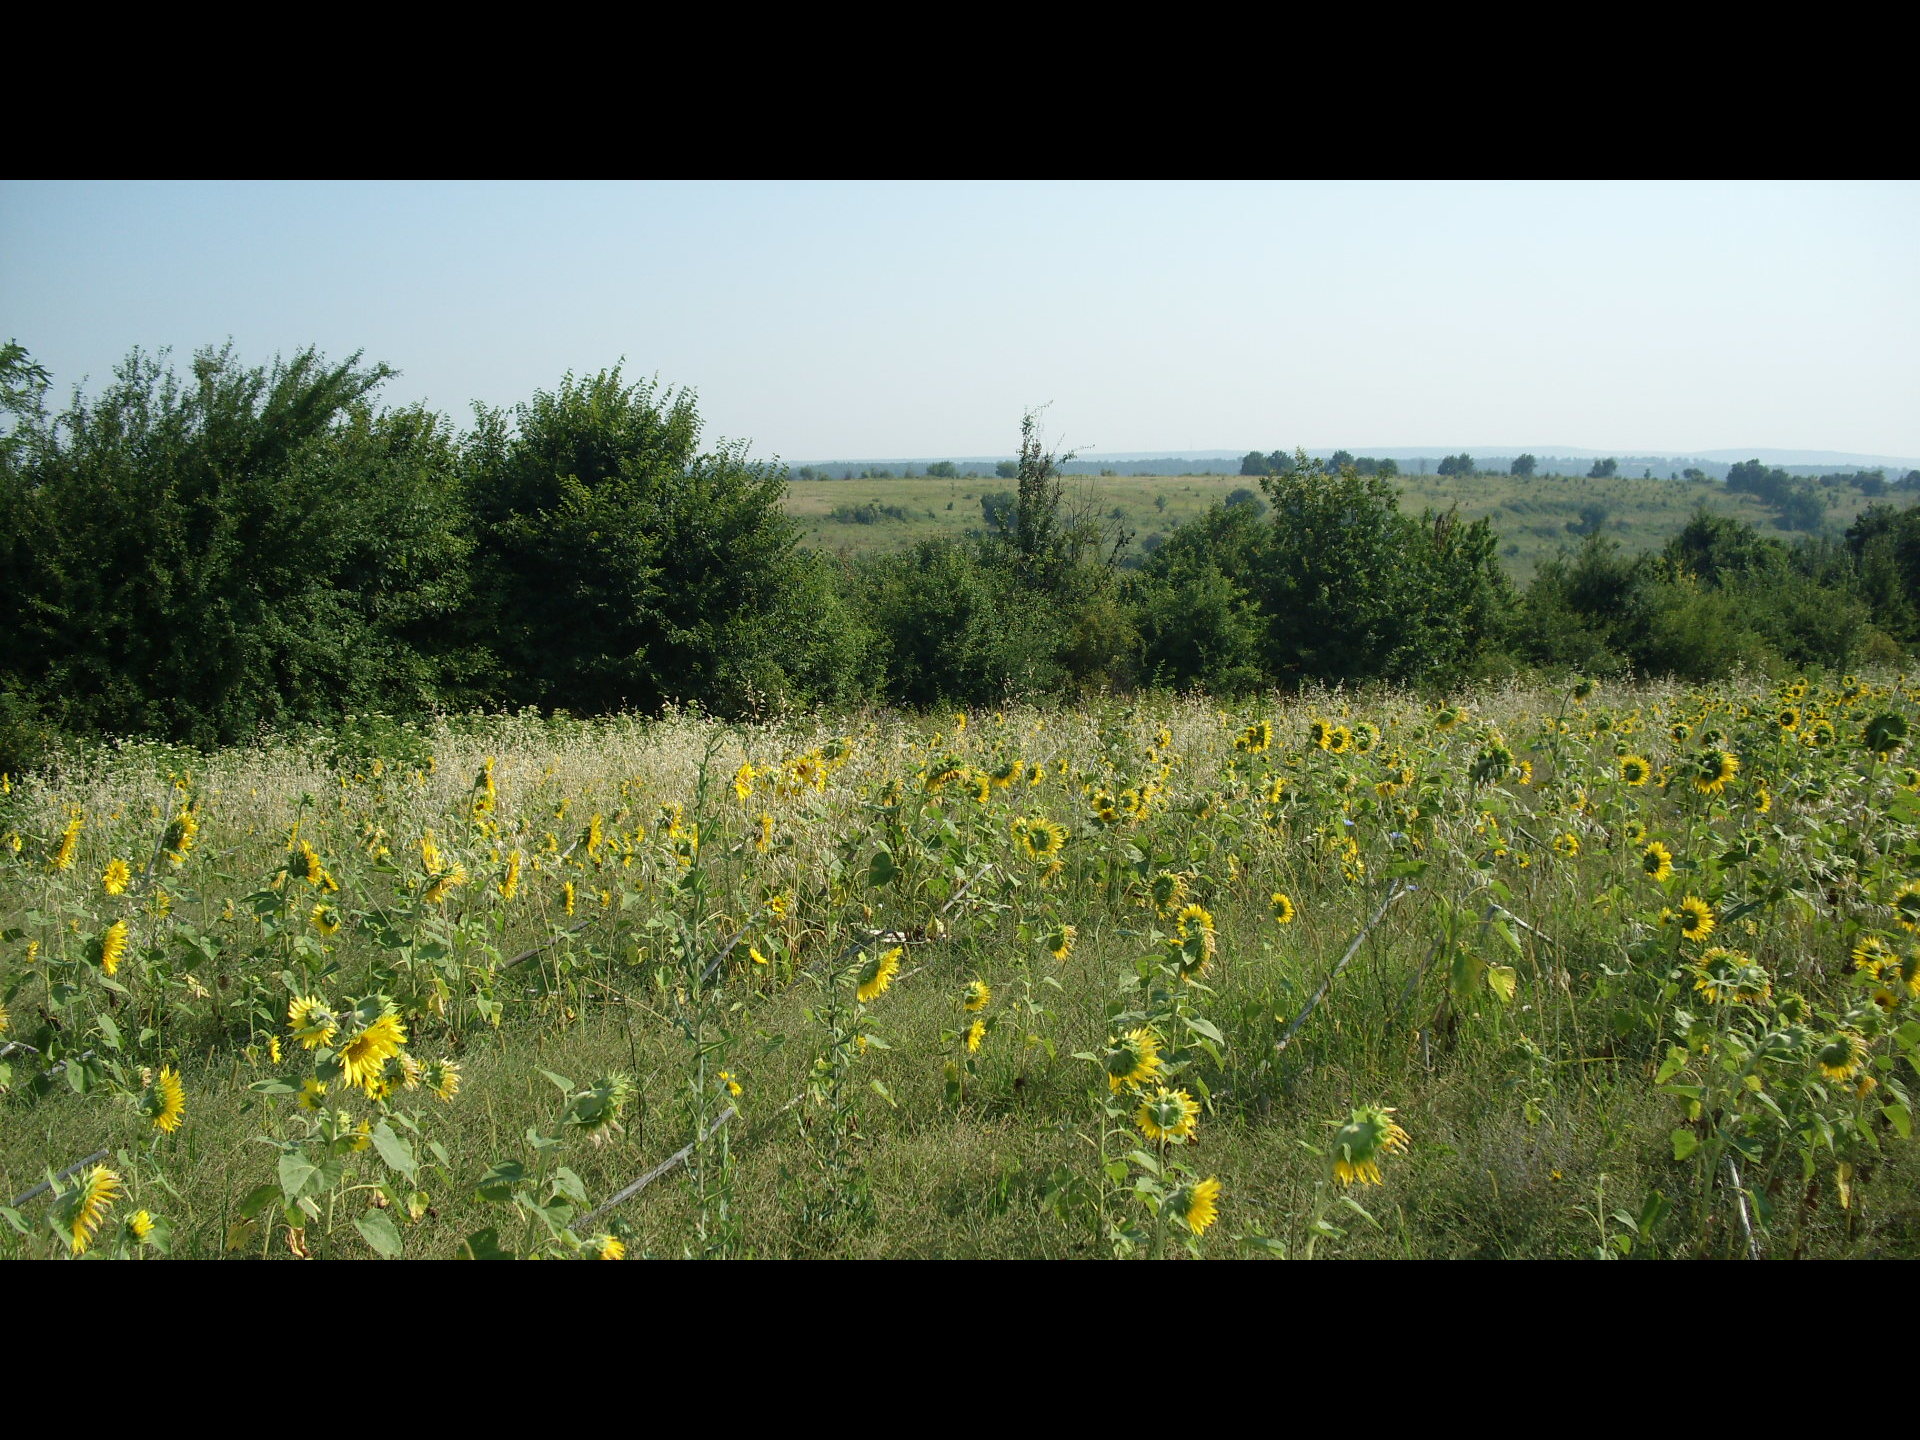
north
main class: Grassland
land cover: Spontaneously vegetated surfaces
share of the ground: > 75 %
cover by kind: herbaceous plants 100 %
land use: Fallow land
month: July
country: BG
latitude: 43.7436
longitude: 22.8898
